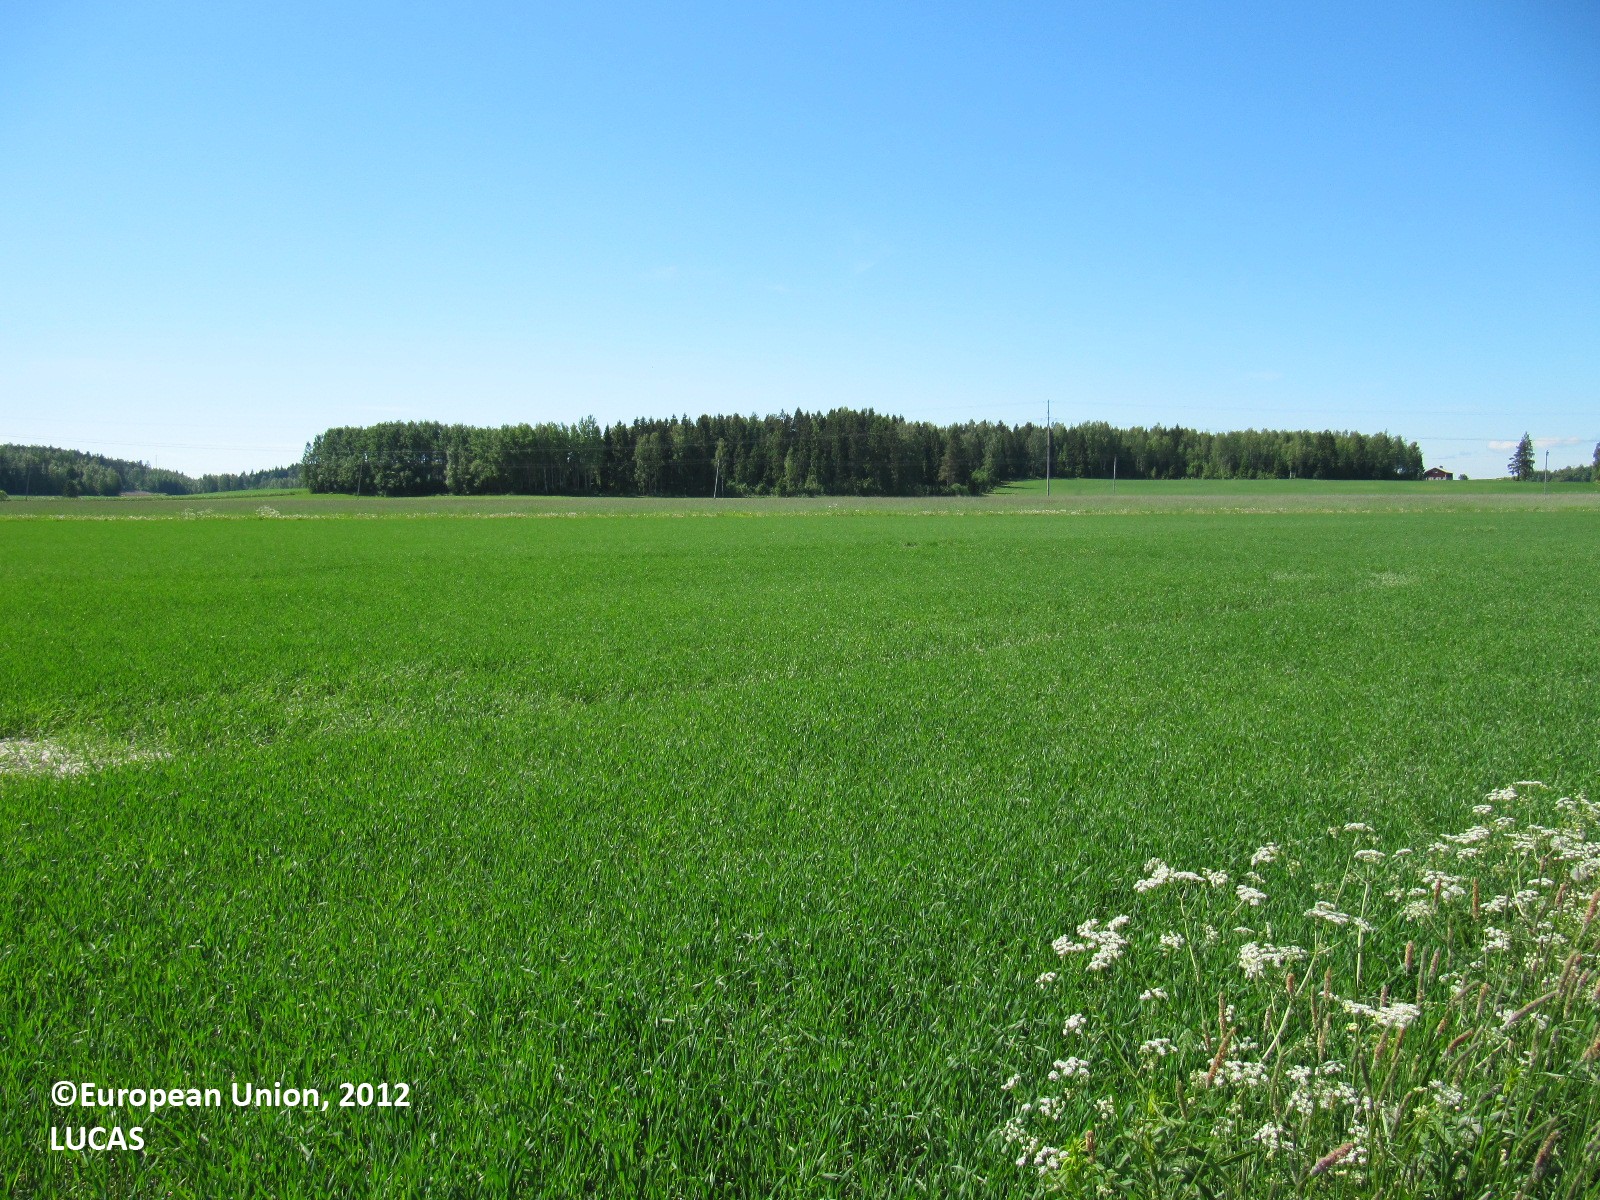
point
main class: Cropland
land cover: Common wheat
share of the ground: > 75 %
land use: Agriculture (excluding fallow land and kitchen gardens)
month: June
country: FI
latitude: 60.1144
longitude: 24.2273
